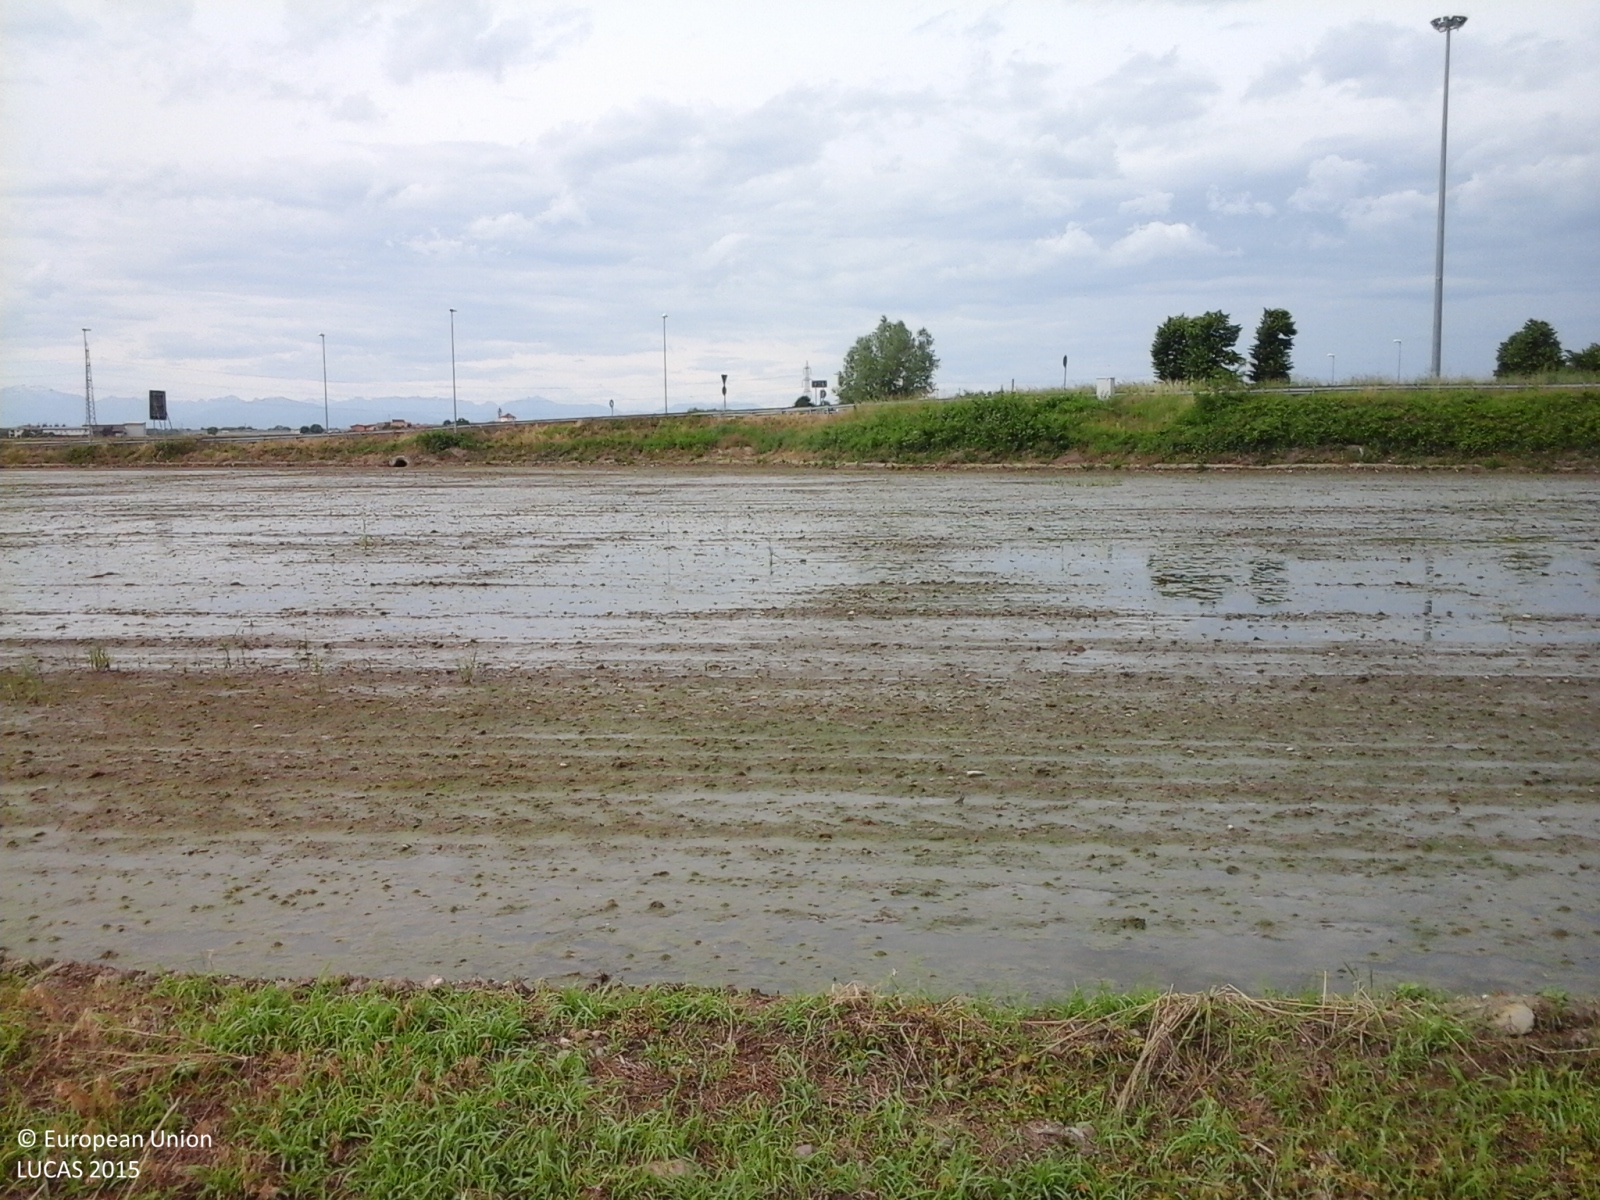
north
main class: Cropland
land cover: Rice
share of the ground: < 10 %
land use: Agriculture (excluding fallow land and kitchen gardens)
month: May
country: IT
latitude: 45.4765
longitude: 8.5569
